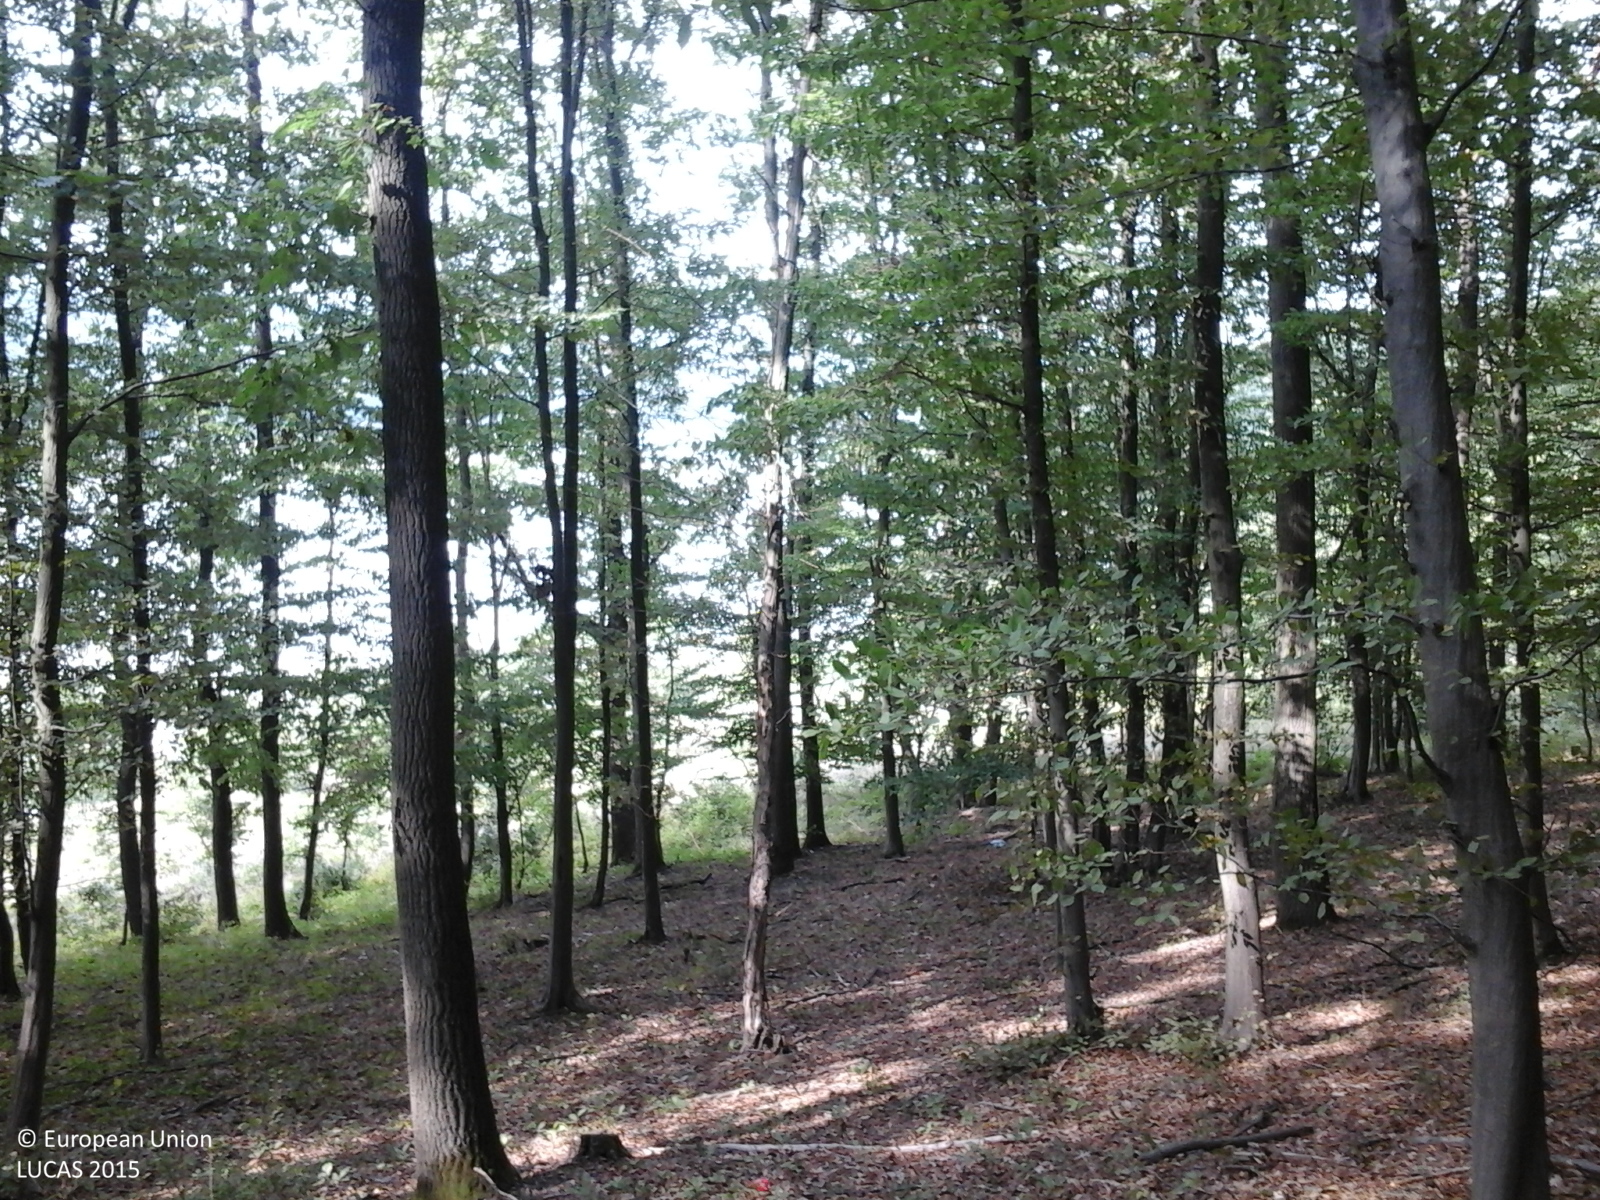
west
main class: Woodland
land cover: Broadleaved woodland
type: acidophilous oak and oak-birch forest
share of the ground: > 75 %
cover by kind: broadleaved forest trees 100 %
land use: Forestry
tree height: > 5 m
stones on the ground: < 10 %
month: September
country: RO
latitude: 45.9387
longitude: 22.8353
